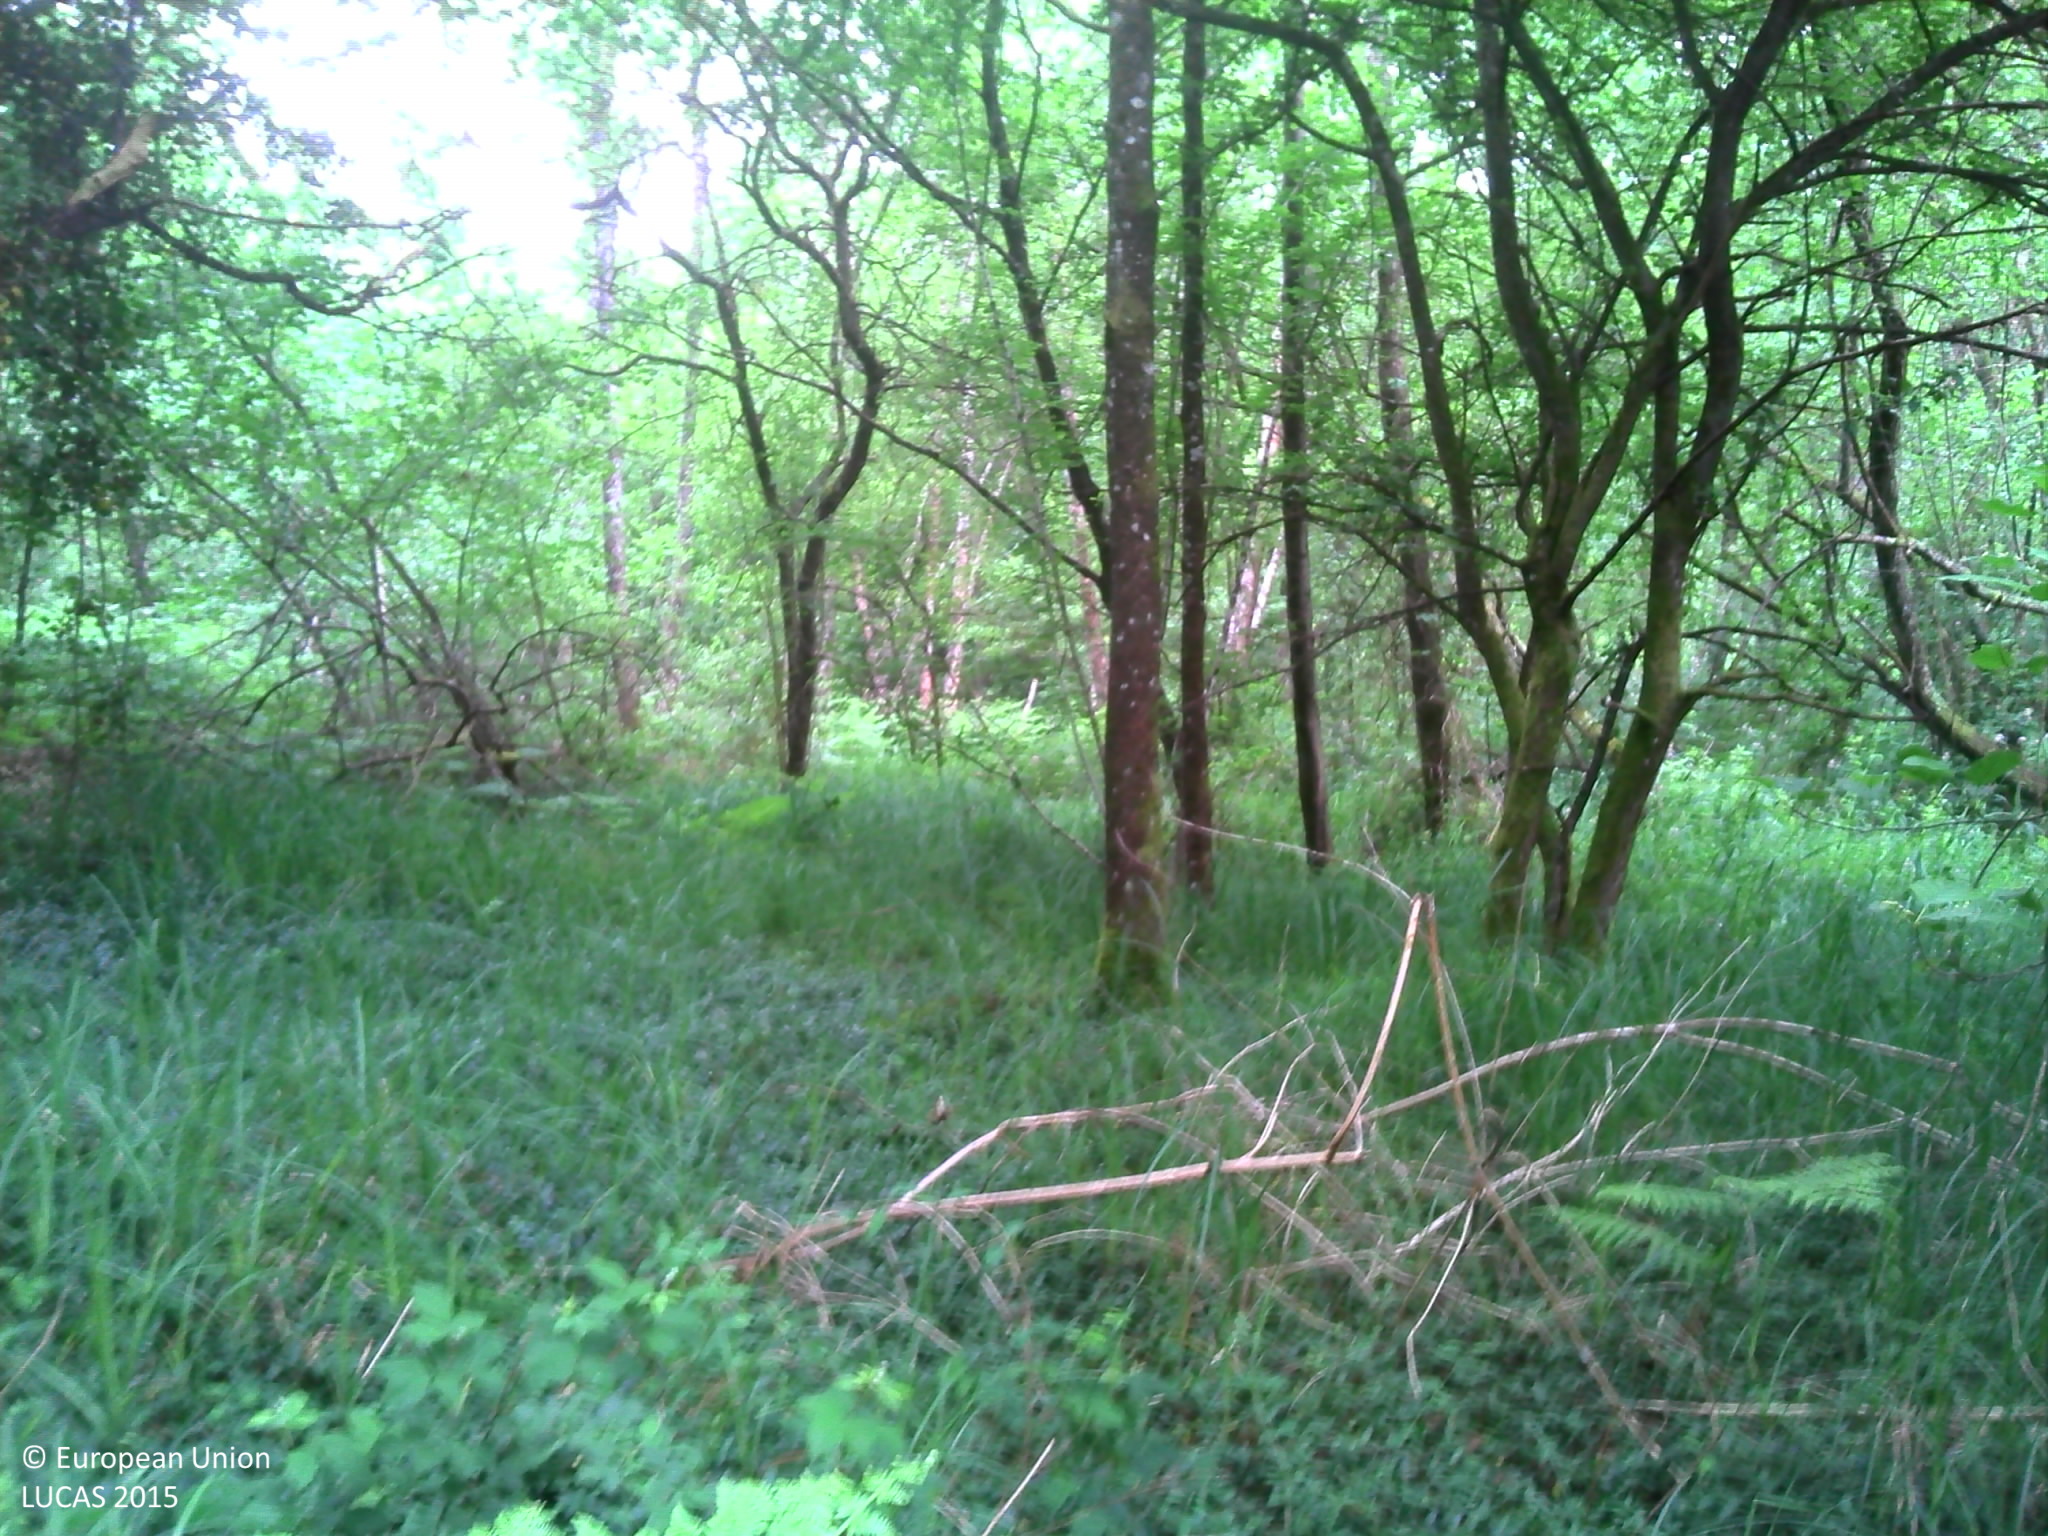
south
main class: Woodland
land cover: Broadleaved woodland
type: acidophilous oak and oak-birch forest
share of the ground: > 75 %
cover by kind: broadleaved forest trees 60 %, herbaceous plants 20 %, coniferous forest trees 10 %, lichens and mosses 10 %
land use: Forestry
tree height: > 5 m
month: June
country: FR
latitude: 47.4808
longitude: 0.0349
